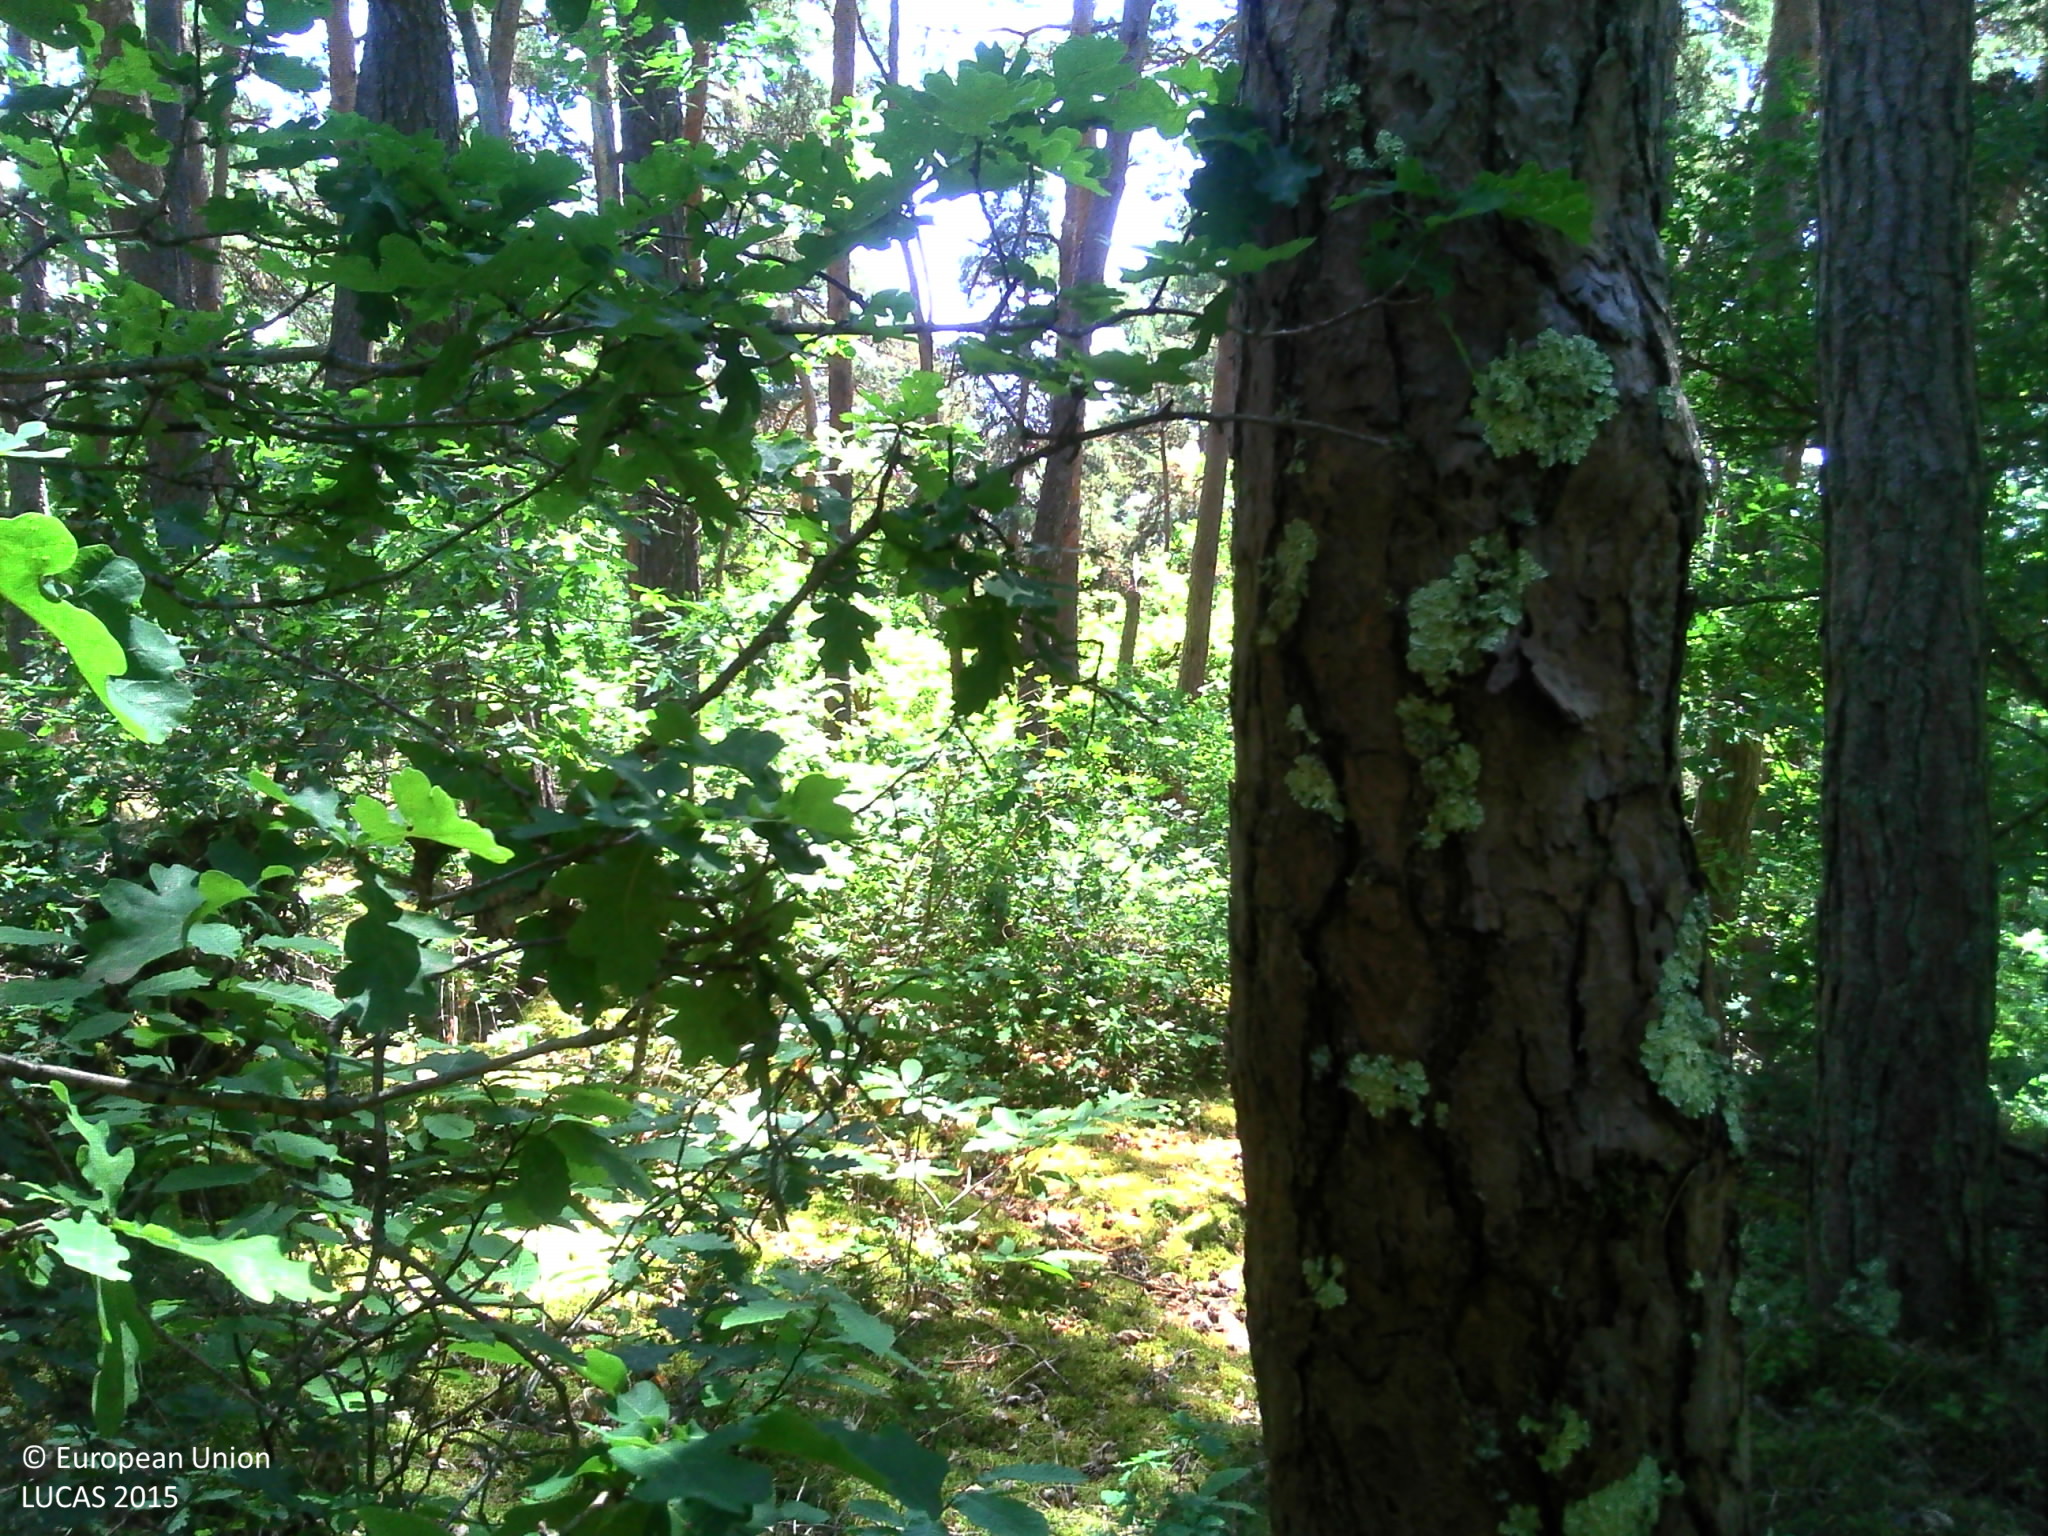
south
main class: Woodland
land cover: Pine dominated mixed woodland
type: hemiboreal forest and nemoral coniferous forest and mixed broadleaved-coniferous forest
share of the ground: > 75 %
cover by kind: coniferous forest trees 75 %, broadleaved forest trees 25 %
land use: Forestry
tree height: > 5 m
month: July
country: FR
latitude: 45.3195
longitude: 3.4580
